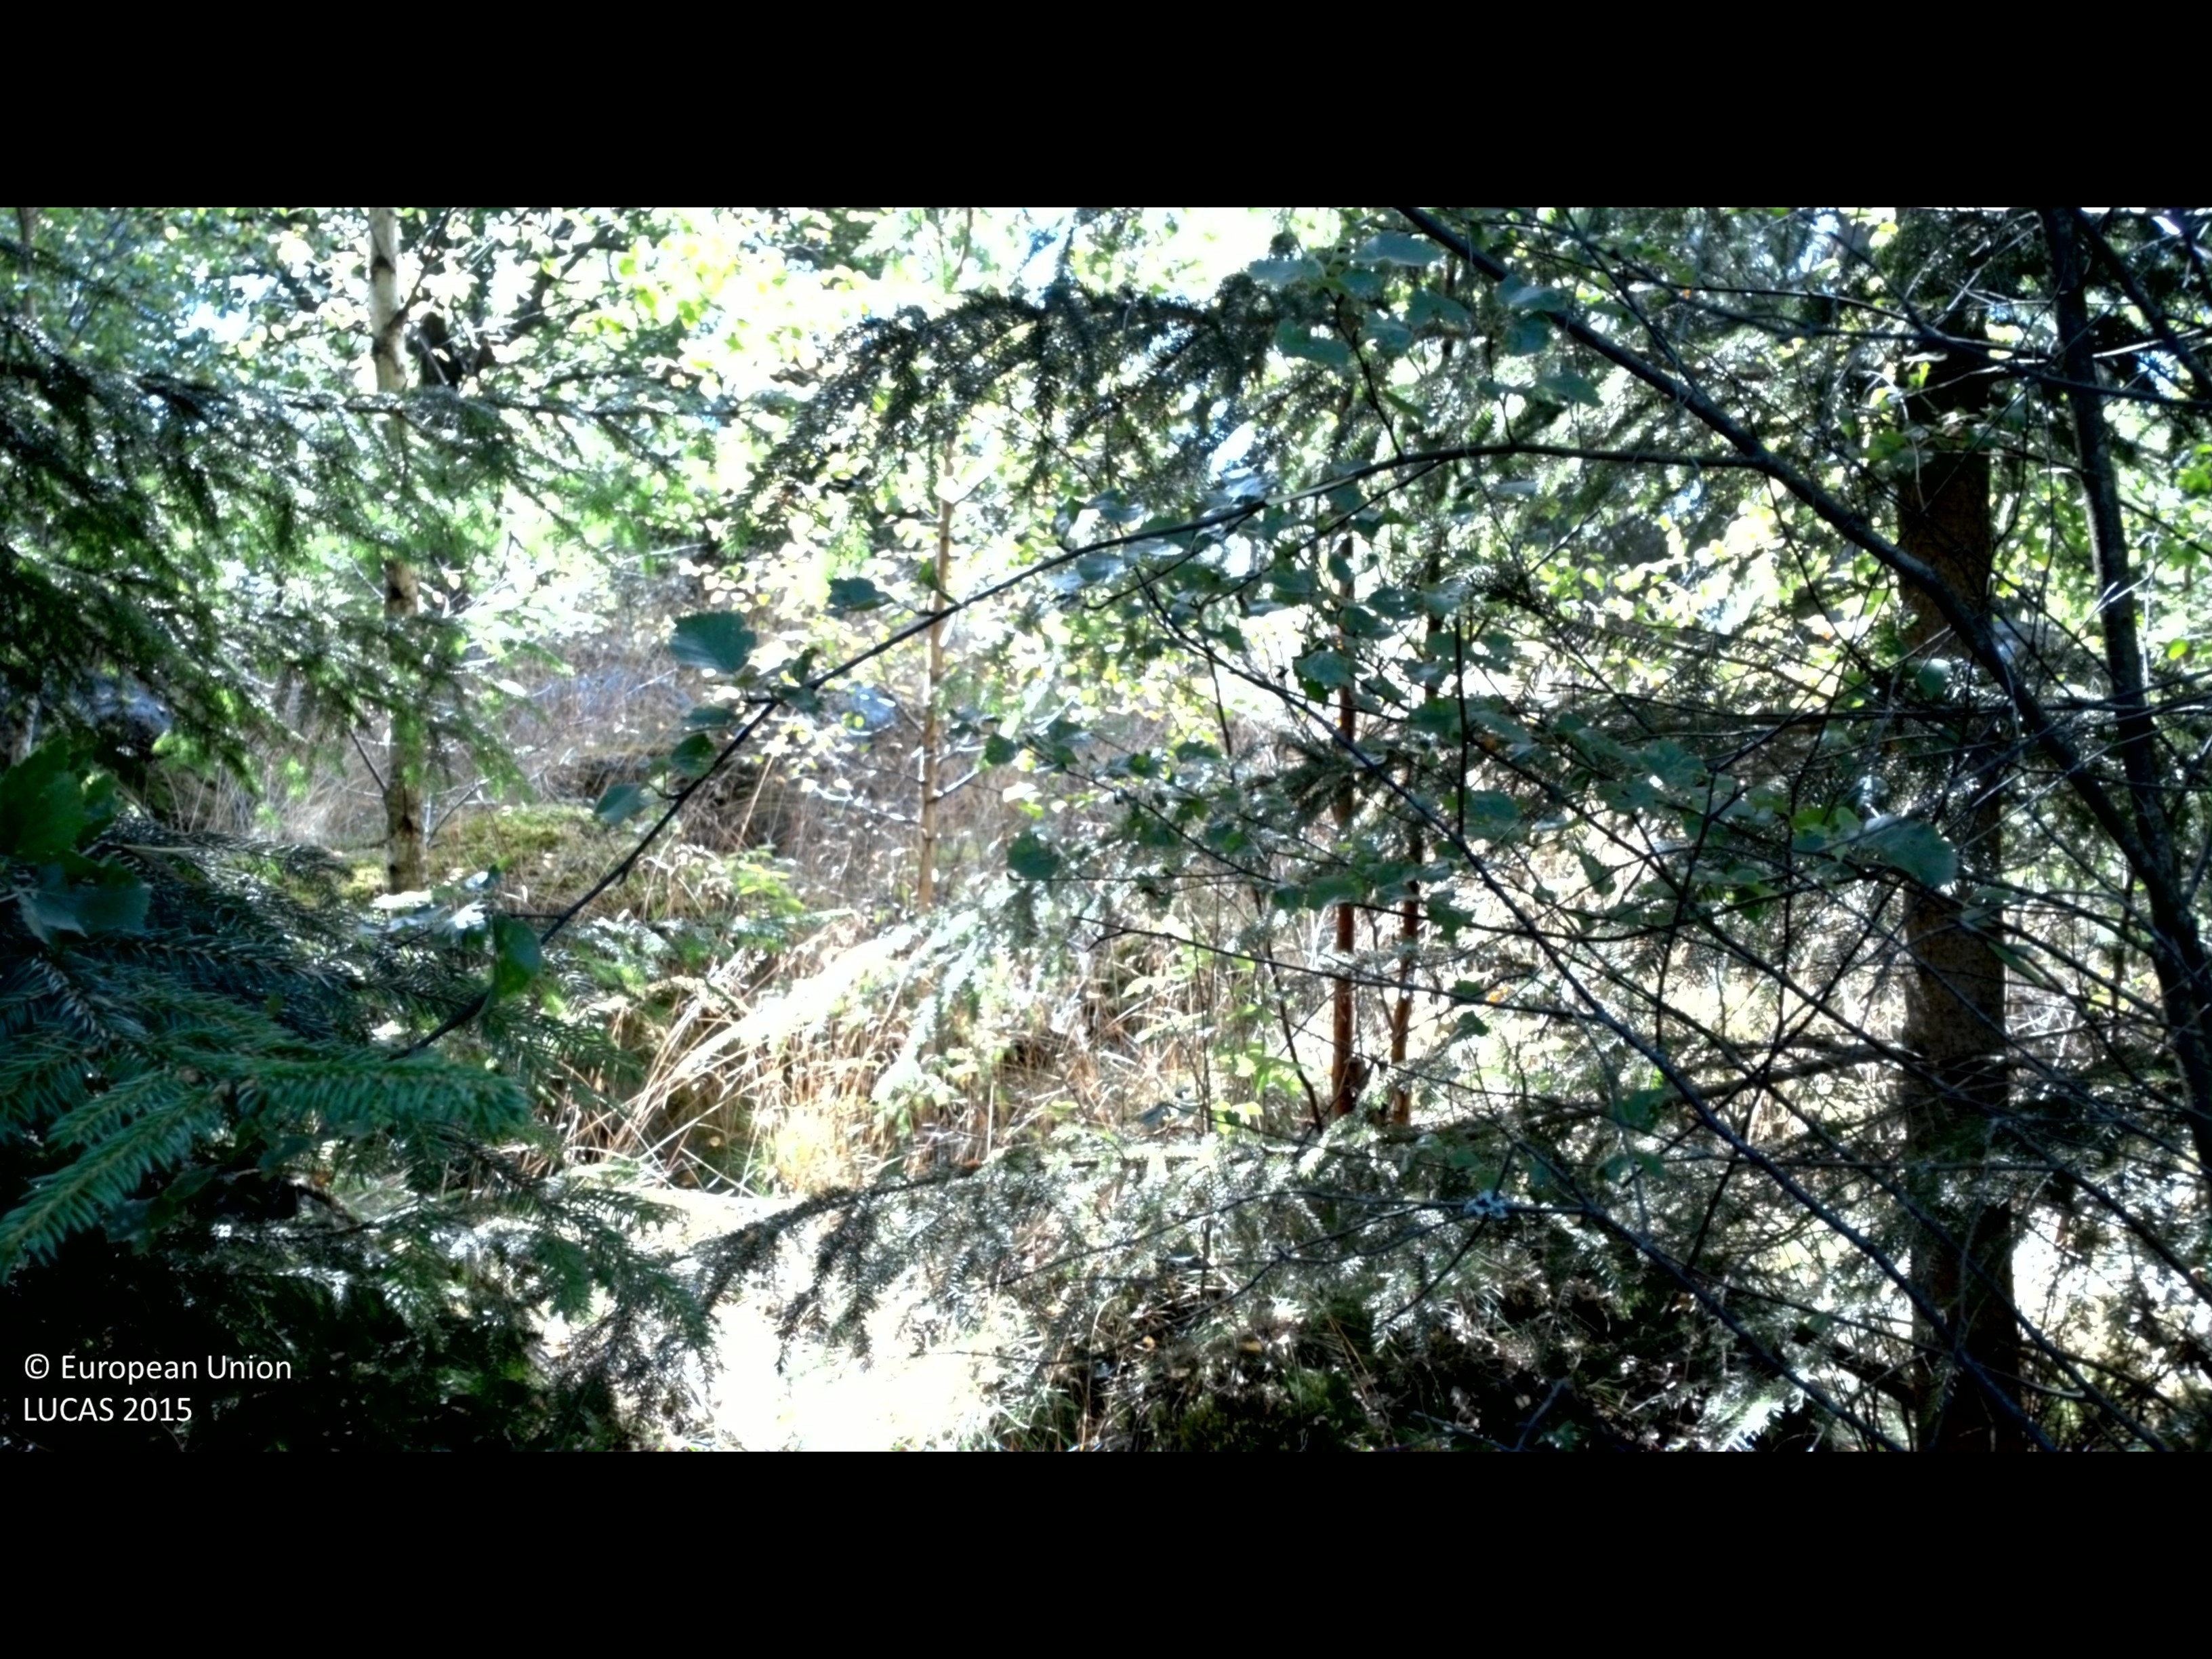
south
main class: Woodland
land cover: Spruce dominated mixed woodland
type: boreal forest
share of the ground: 50 - 75 %
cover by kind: coniferous forest trees 40 %, herbaceous plants 30 %, broadleaved forest trees 25 %, shrubs 5 %
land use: Forestry
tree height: > 5 m
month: August
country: SE
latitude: 56.2867
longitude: 15.8969
